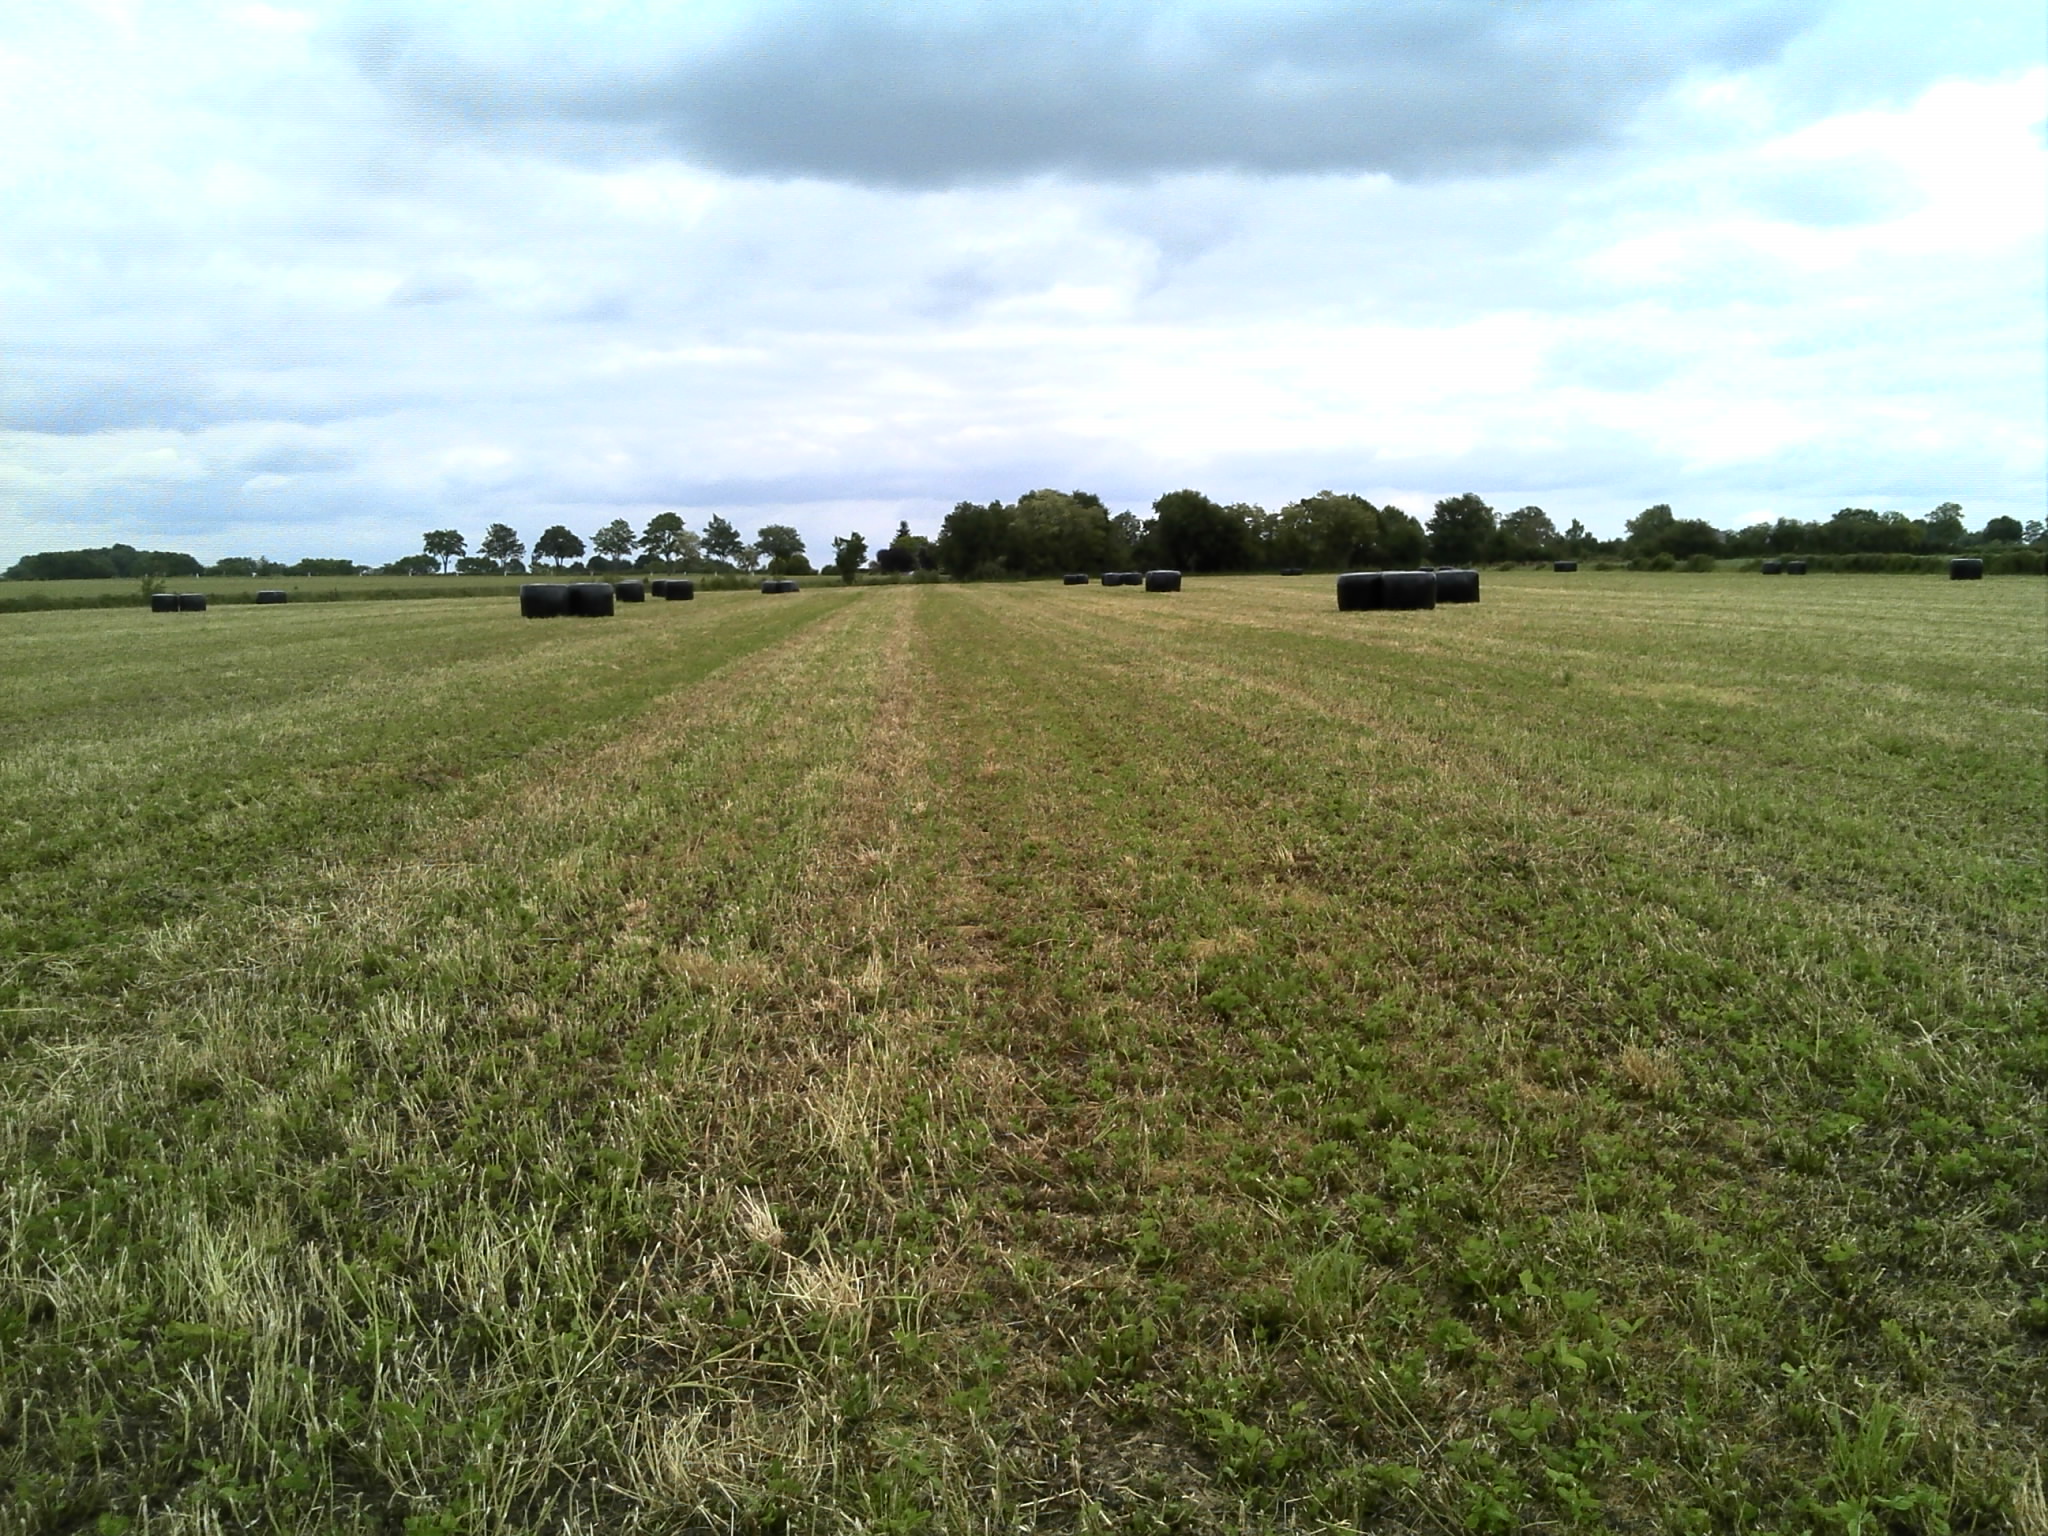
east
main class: Cropland
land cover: Clovers
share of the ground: > 75 %
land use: Agriculture (excluding fallow land and kitchen gardens)
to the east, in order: Clovers; Fences; Ditches and canals; Tracks; Ditches and canals; Durum wheat
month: May
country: FR
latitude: 46.5375
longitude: 1.5010
